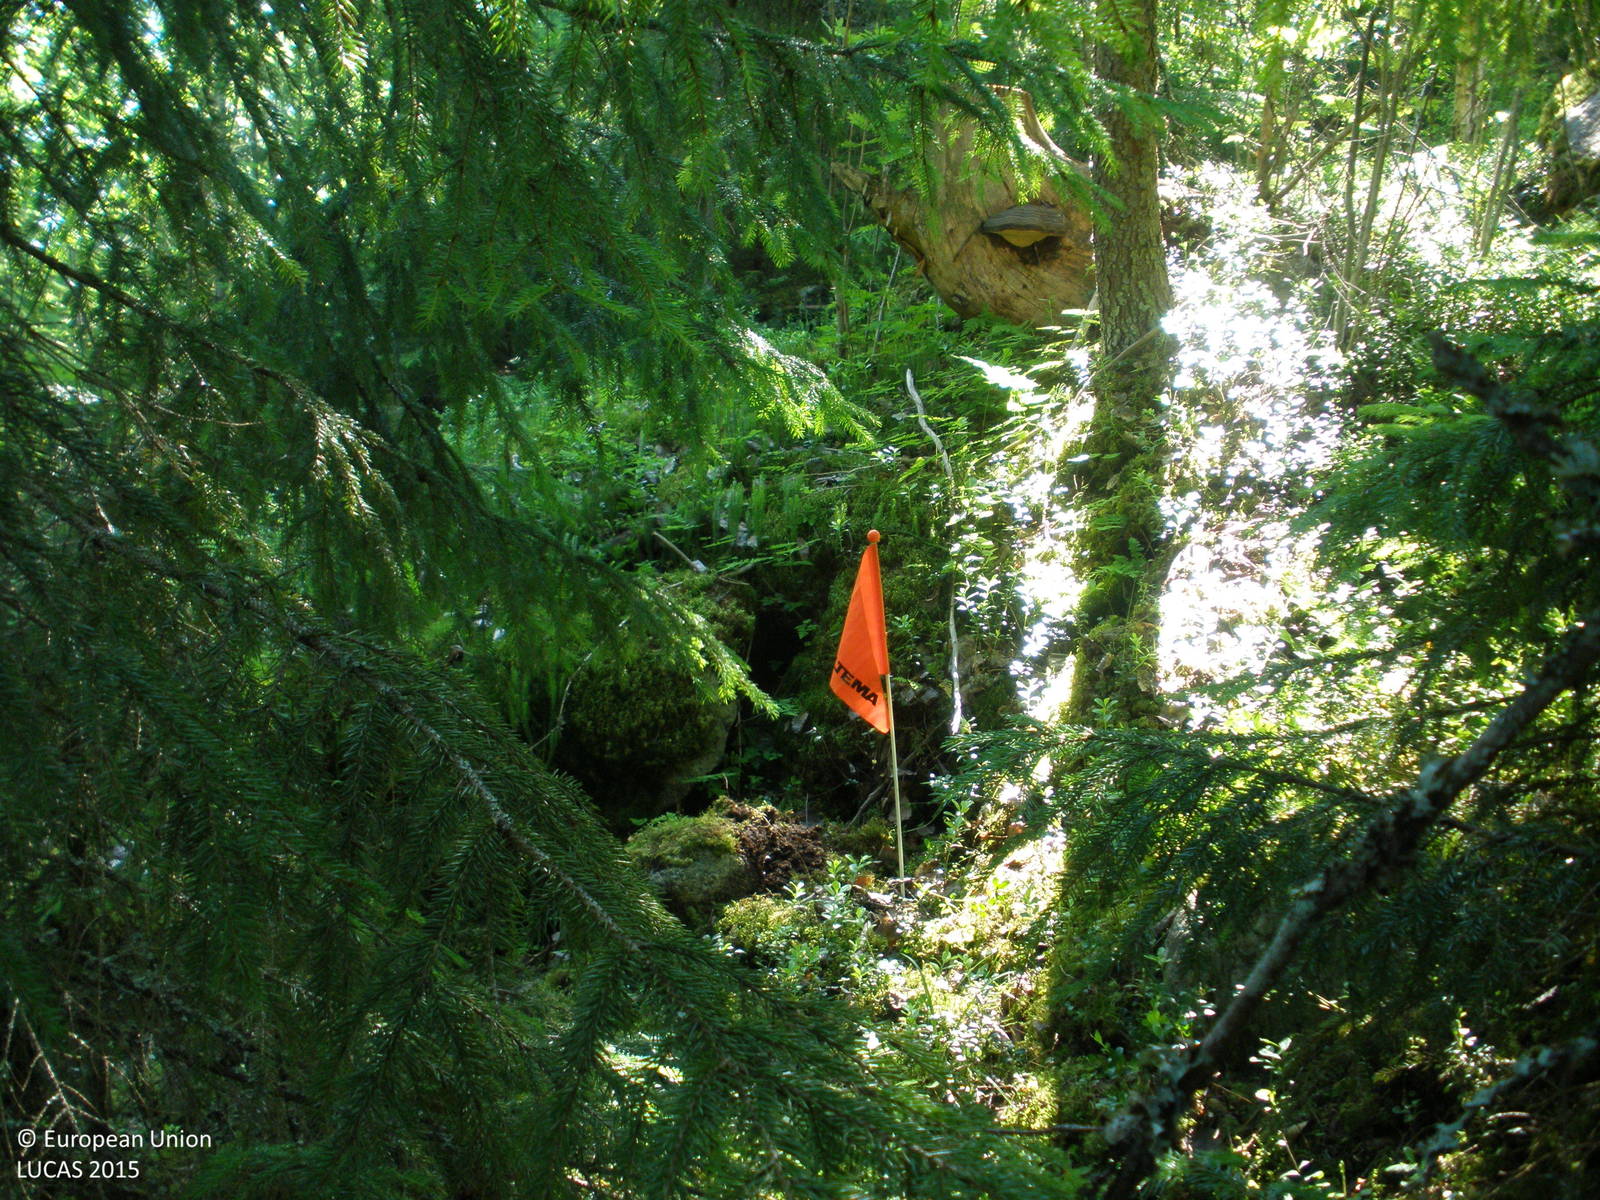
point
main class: Woodland
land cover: Spruce dominated mixed woodland
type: boreal forest
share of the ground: > 75 %
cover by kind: coniferous forest trees 60 %, broadleaved forest trees 25 %, herbaceous plants 10 %, lichens and mosses 5 %
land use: Forestry
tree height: > 5 m
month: July
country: FI
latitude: 61.2018
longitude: 23.6124
